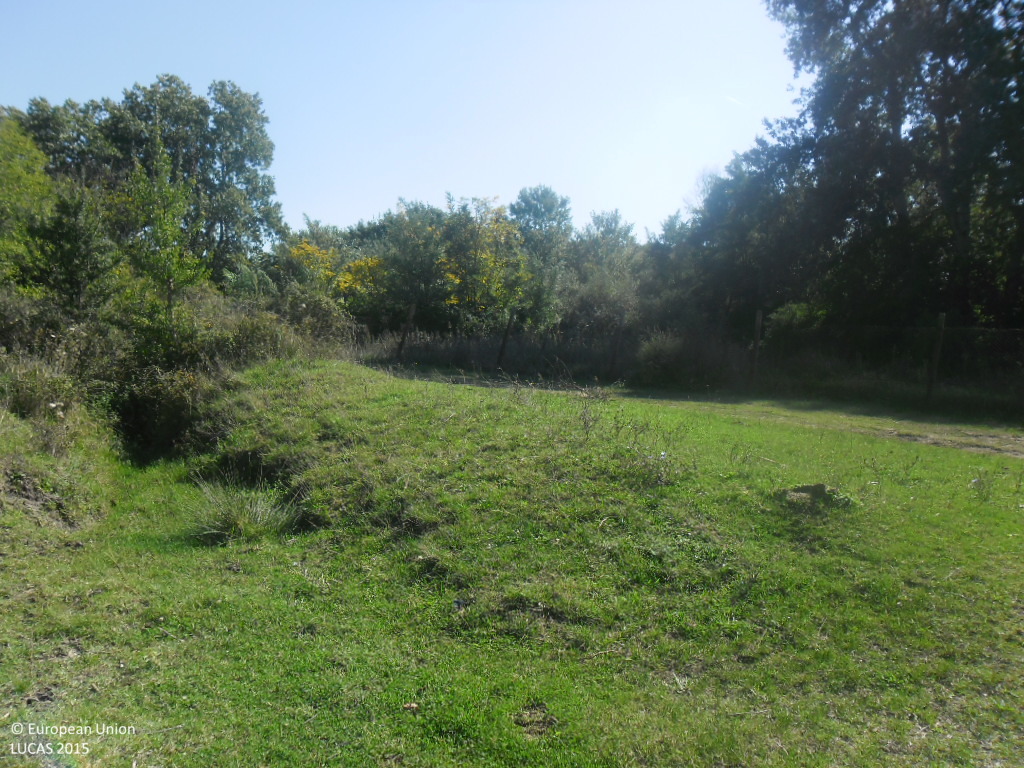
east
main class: Grassland
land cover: Grassland without tree/shrub cover
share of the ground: > 75 %
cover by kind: herbaceous plants 100 %
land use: Agriculture (excluding fallow land and kitchen gardens)
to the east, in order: Grassland without tree/shrub cover; Fences; Grassland without tree/shrub cover; Shrubland with sparse tree cover; Grassland without tree/shrub cover; Tracks; Fences; Shrubland with sparse tree cover; Grassland without tree/shrub cover; Broadleaved woodland; Grassland without tree/shrub cover; Grassland with sparse tree/shrub cover
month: October
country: BG
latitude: 41.4379
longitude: 23.3417
